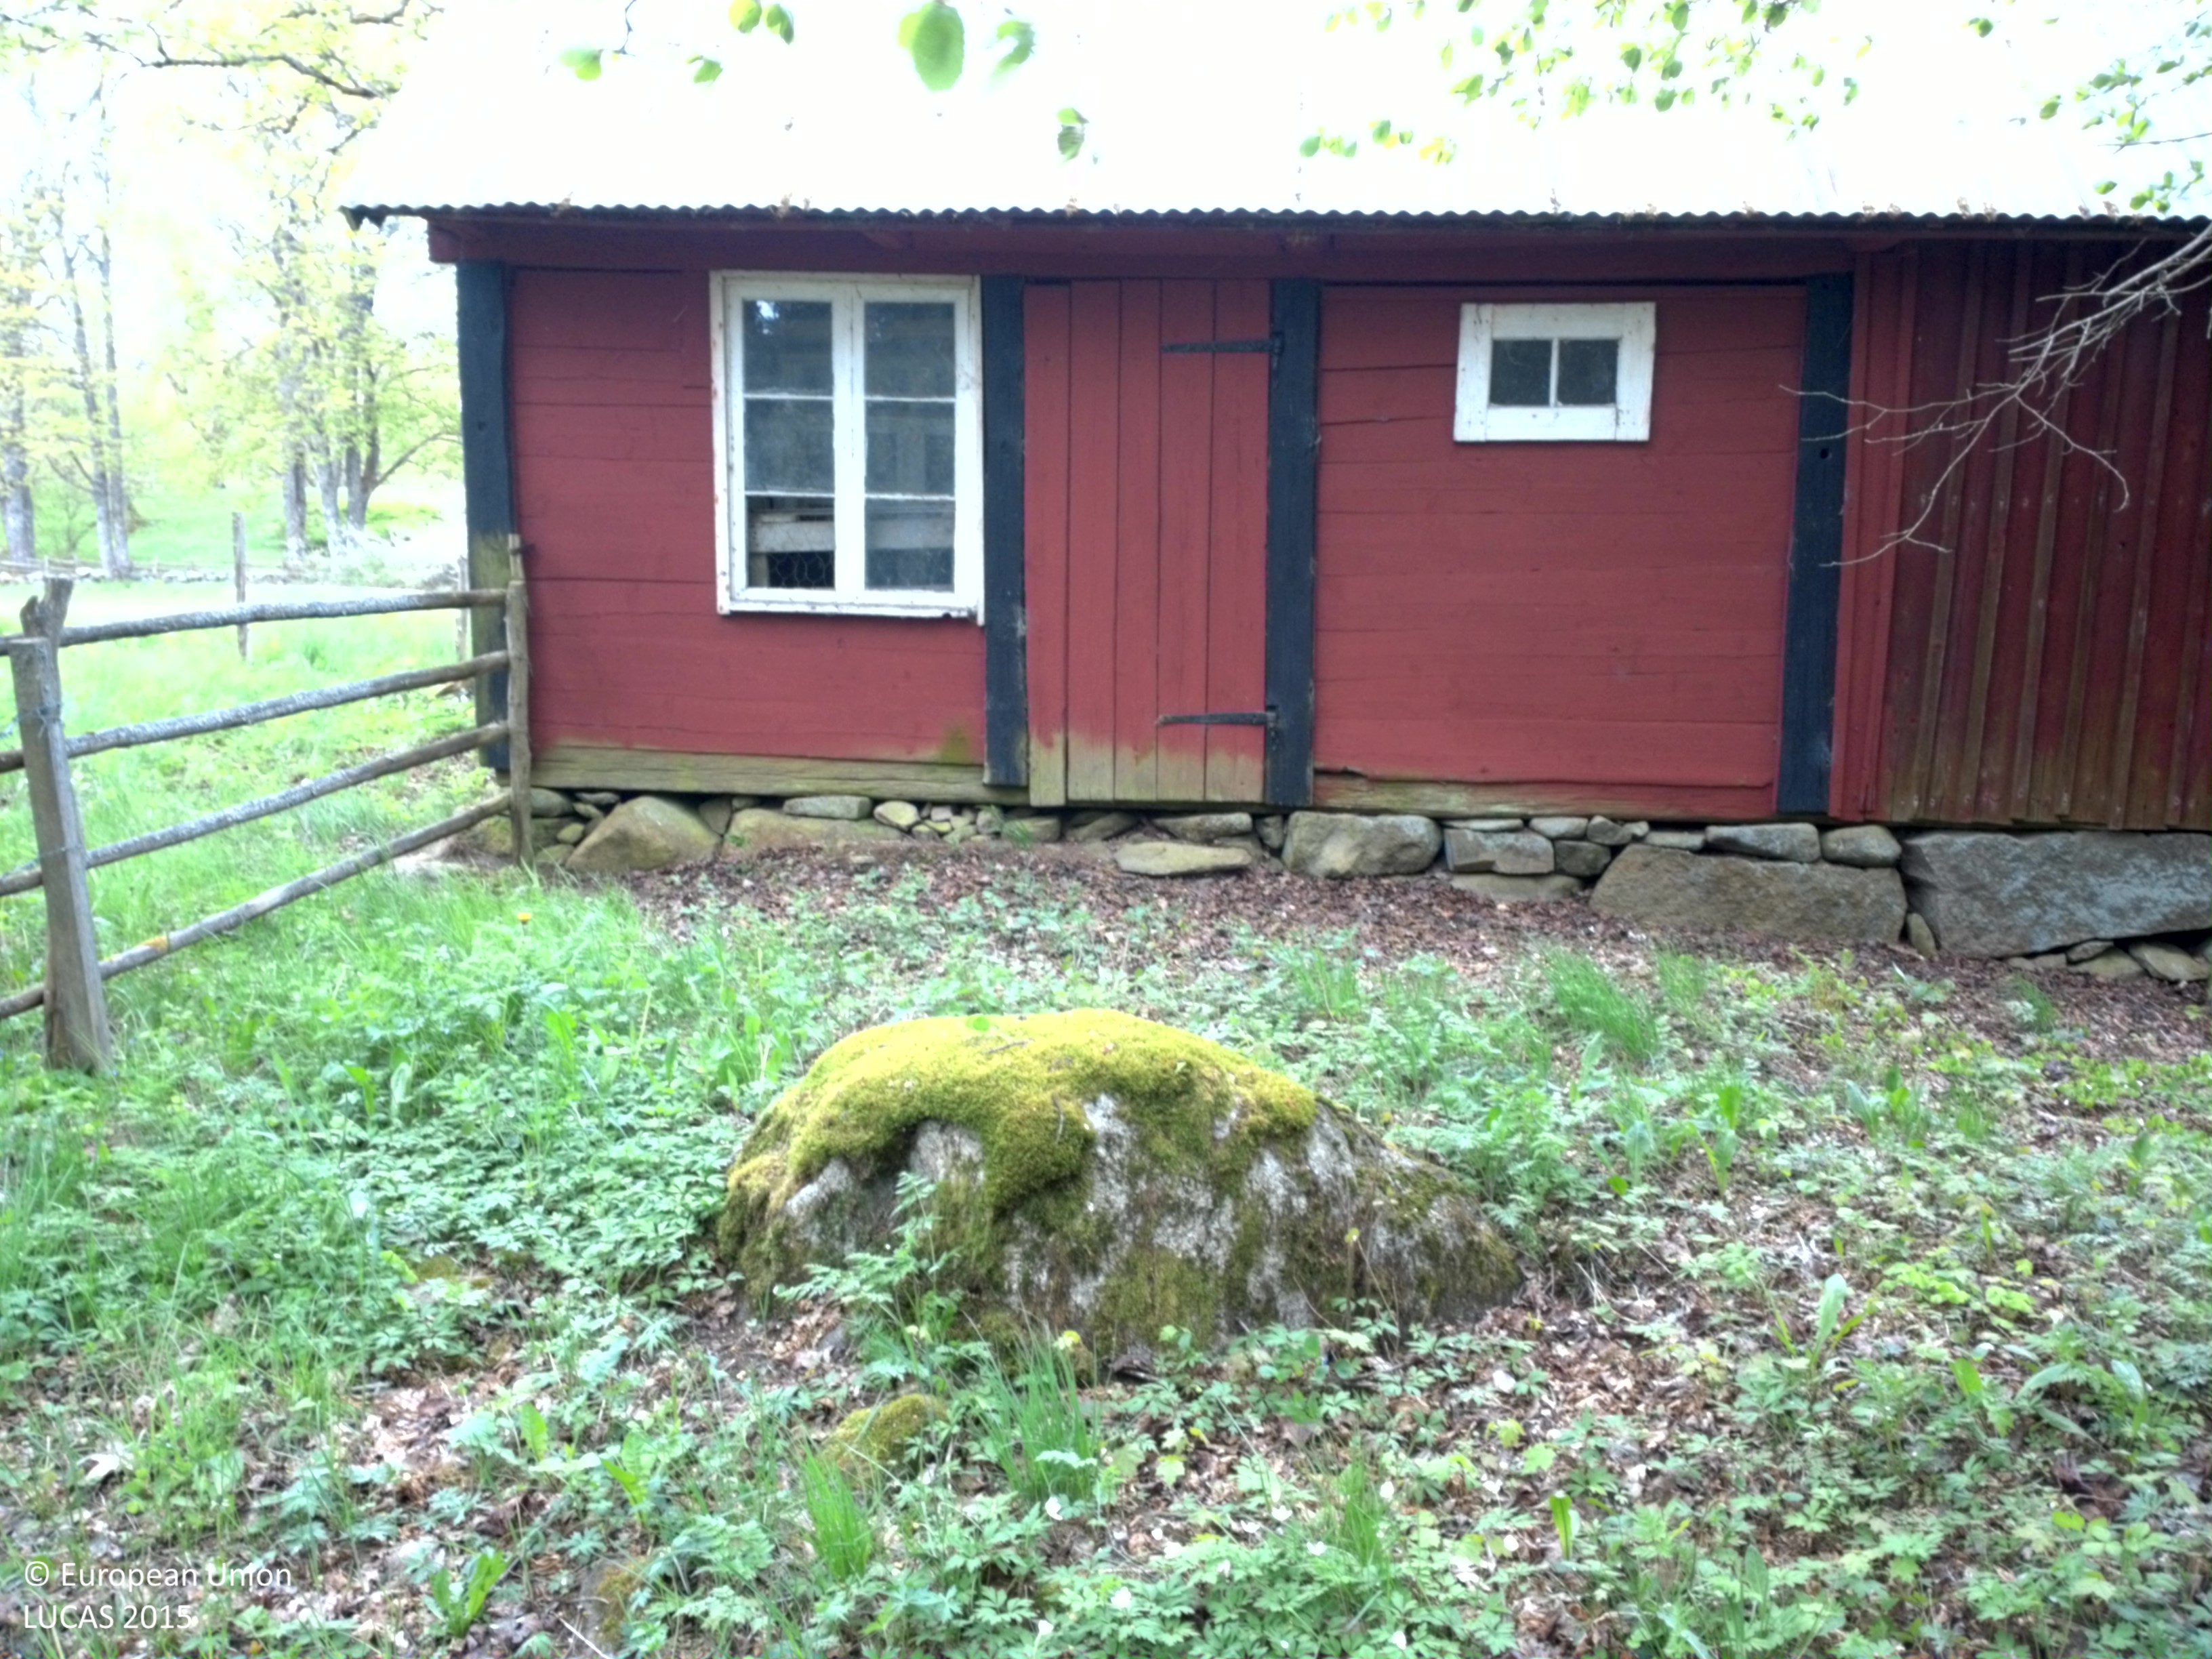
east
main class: Woodland
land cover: Broadleaved woodland
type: hemiboreal forest and nemoral coniferous forest and mixed broadleaved-coniferous forest
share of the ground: > 75 %
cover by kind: broadleaved forest trees 80 %, shrubs 10 %, herbaceous plants 10 %
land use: Forestry
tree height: > 5 m
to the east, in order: Broadleaved woodland; Artificial constructions in urban areas; Grassland with sparse tree/shrub cover; Electric lines; Fences; Grassland without tree/shrub cover; Fences; Dry stone walls; Broadleaved woodland; Spruce dominated mixed woodland
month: May
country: SE
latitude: 56.6152
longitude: 15.3921
